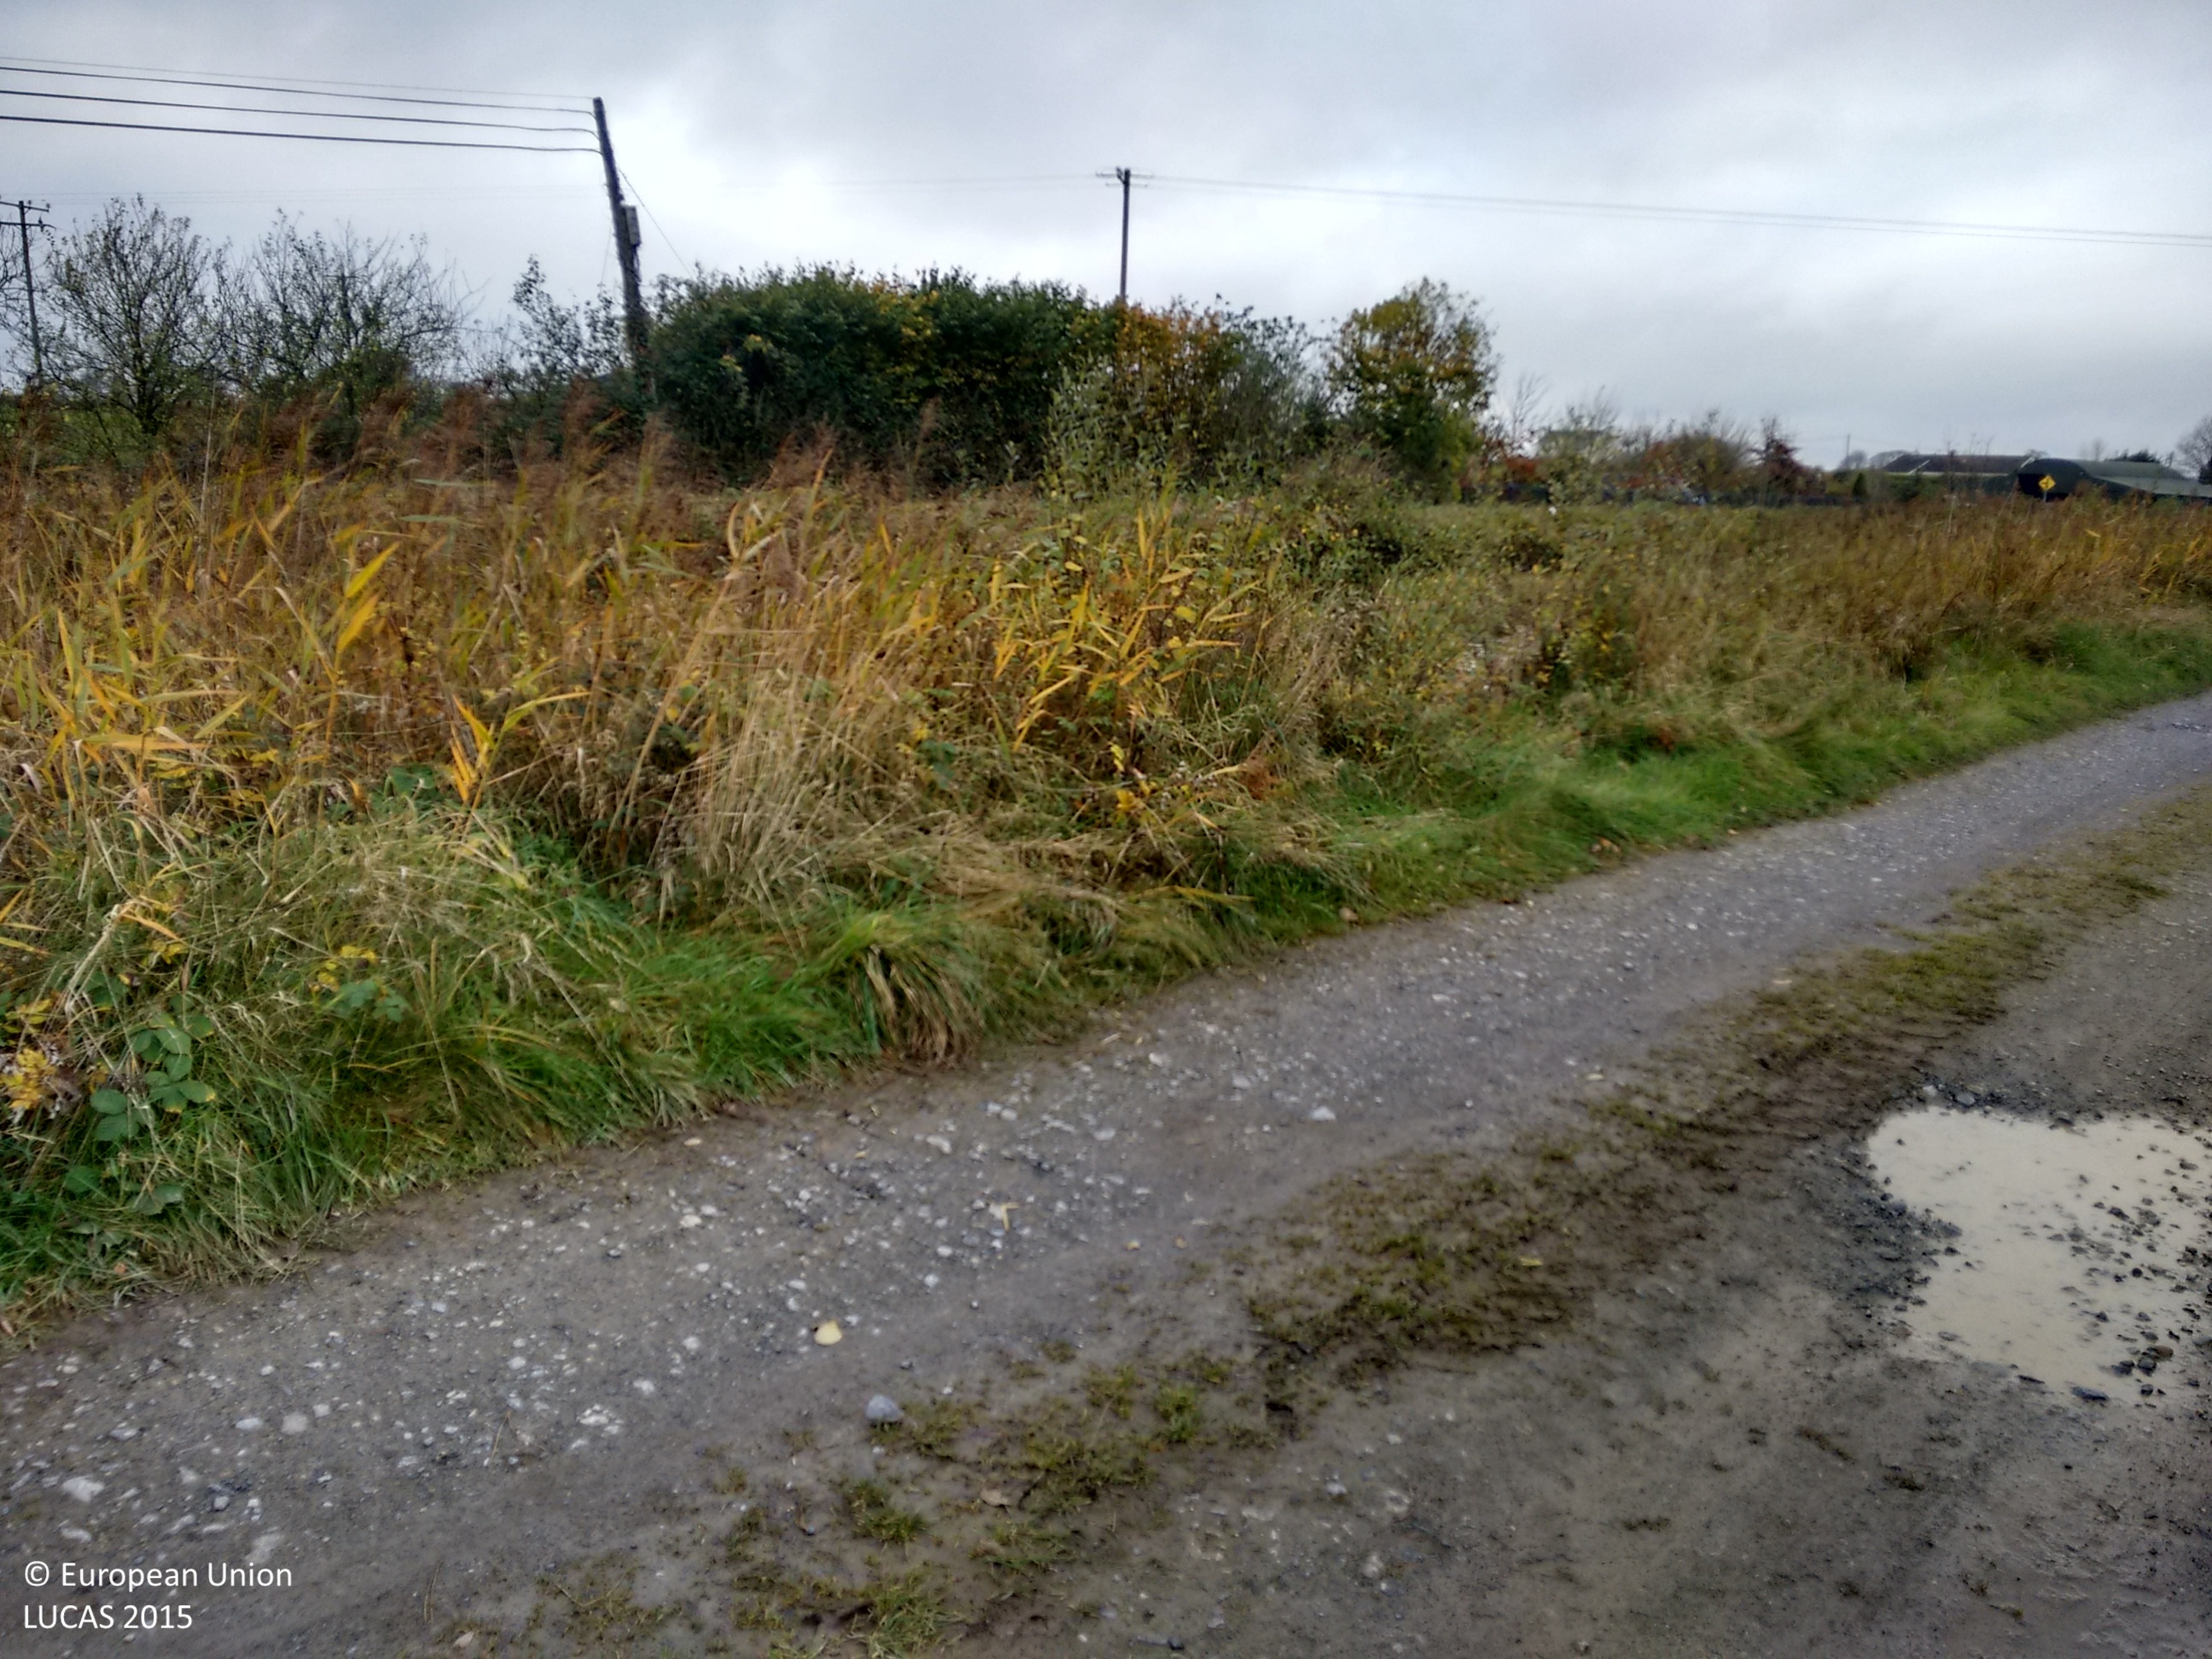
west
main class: Grassland
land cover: Grassland without tree/shrub cover
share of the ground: > 75 %
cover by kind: herbaceous plants 100 %
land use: Agriculture (excluding fallow land and kitchen gardens)
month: October
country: IE
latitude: 53.2769
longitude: -7.6030
